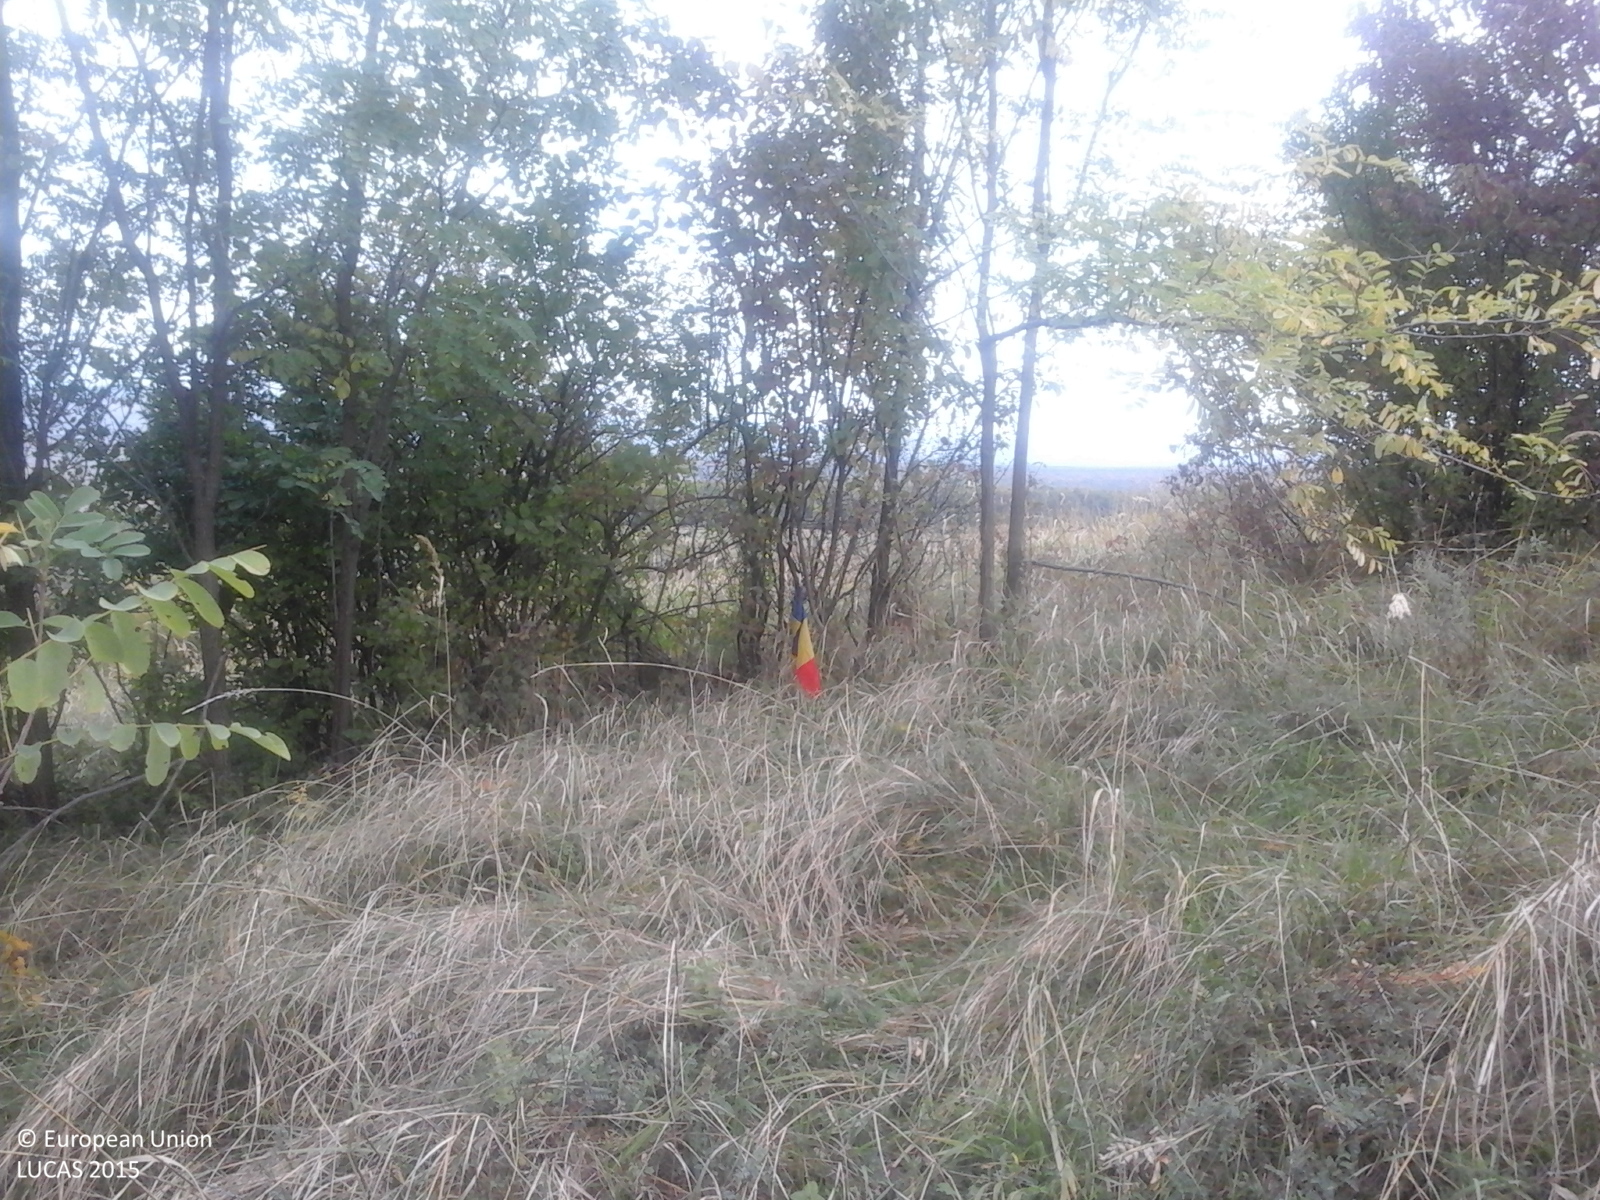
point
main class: Woodland
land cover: Broadleaved woodland
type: exotic forest
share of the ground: > 75 %
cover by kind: broadleaved forest trees 100 %
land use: Forestry
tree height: > 5 m
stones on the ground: < 10 %
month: October
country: RO
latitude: 45.0388
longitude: 26.0411
